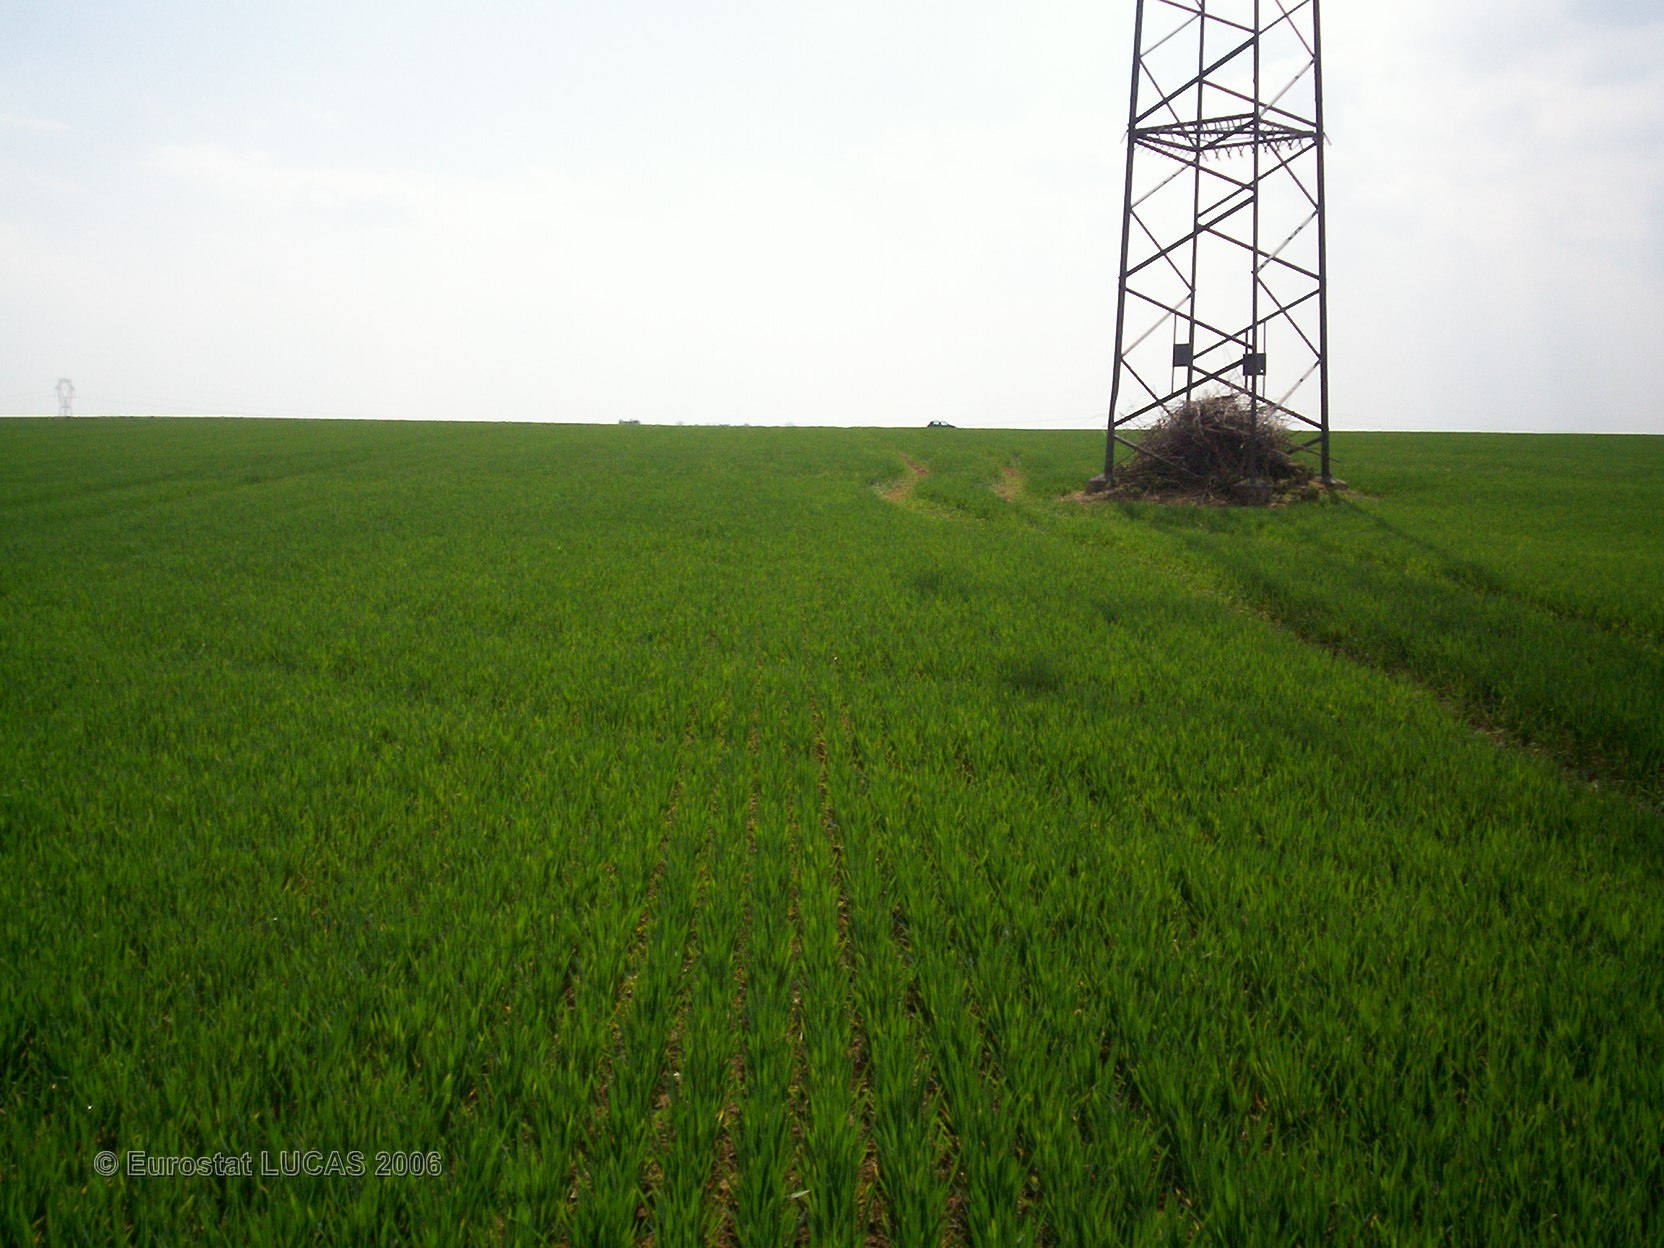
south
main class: Cropland
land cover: Common wheat
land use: Agriculture (excluding fallow land and kitchen gardens)
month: April
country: FR
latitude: 48.8678
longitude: 5.8961
